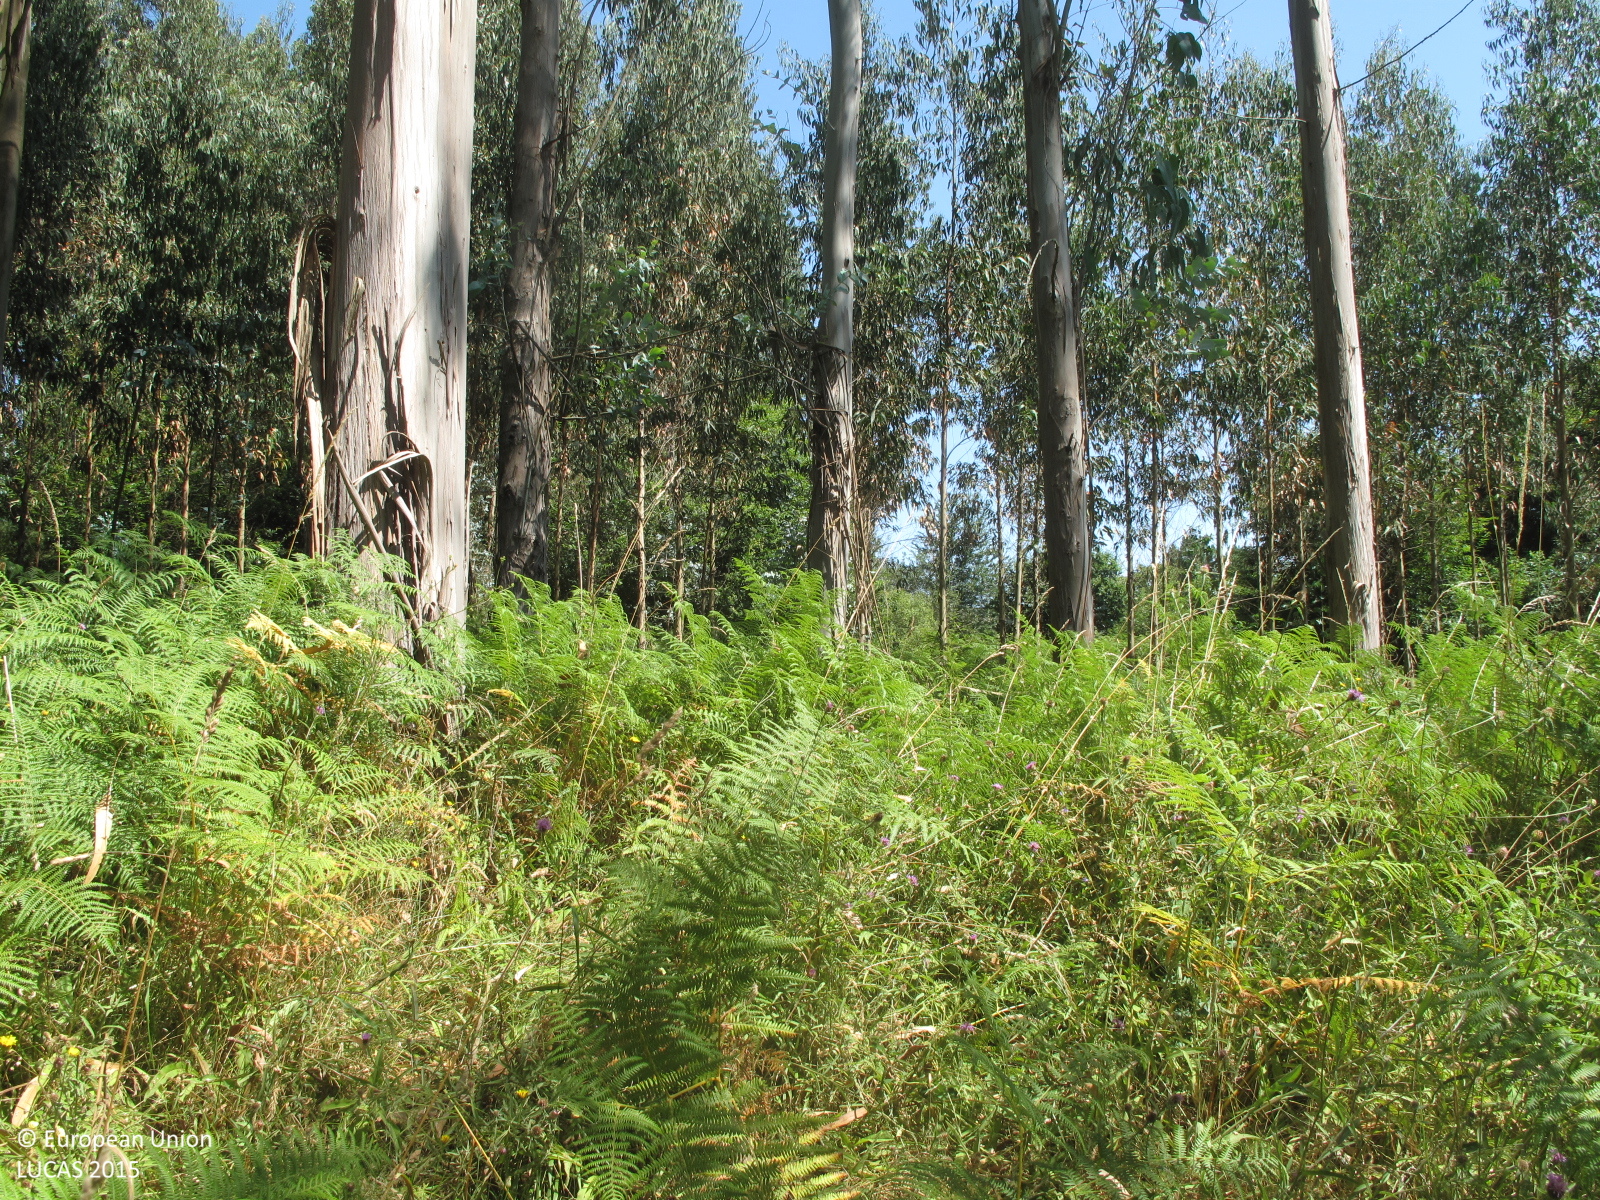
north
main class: Woodland
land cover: Broadleaved woodland
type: exotic forest
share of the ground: 50 - 75 %
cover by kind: broadleaved forest trees 50 %, herbaceous plants 30 %, shrubs 20 %
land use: Forestry
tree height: > 5 m
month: July
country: ES
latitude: 43.2865
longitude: -8.2546
